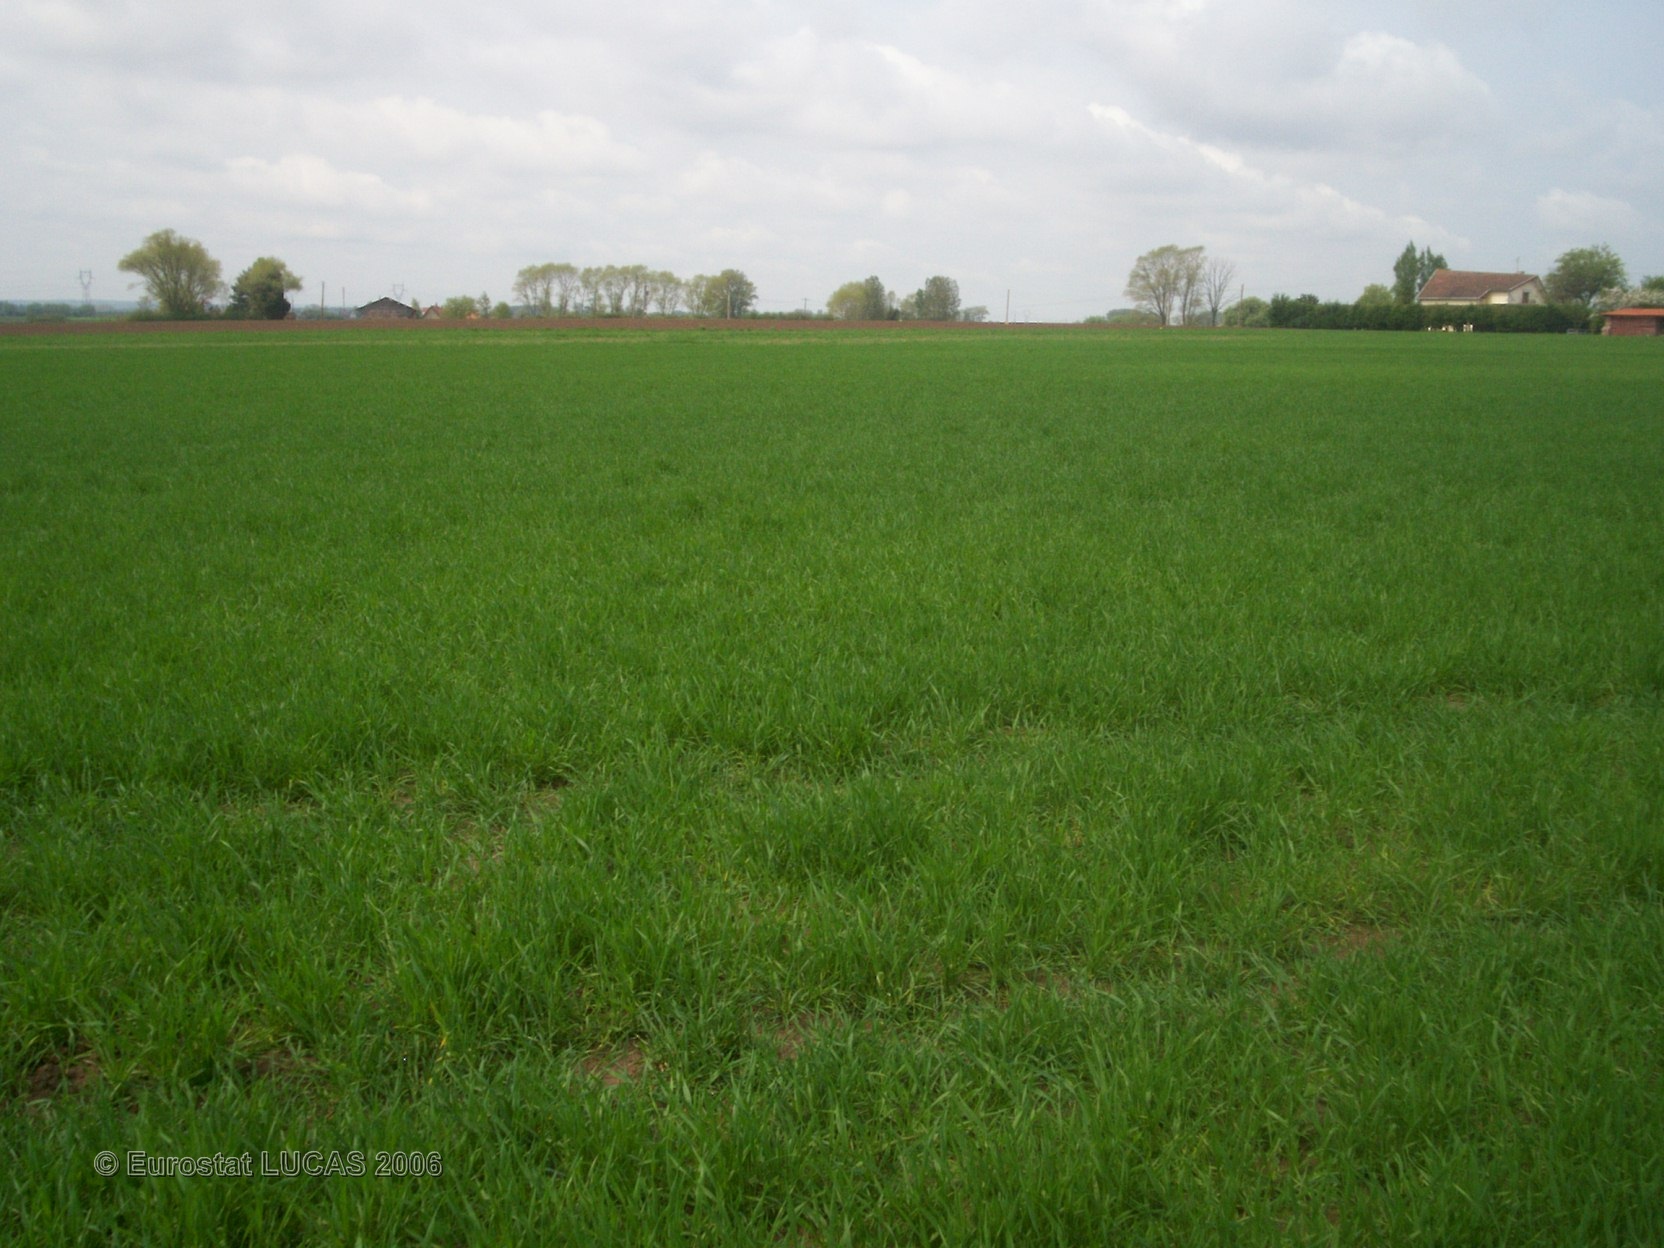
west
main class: Cropland
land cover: Common wheat
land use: Agriculture (excluding fallow land and kitchen gardens)
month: May
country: FR
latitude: 50.8987
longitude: 2.2937
